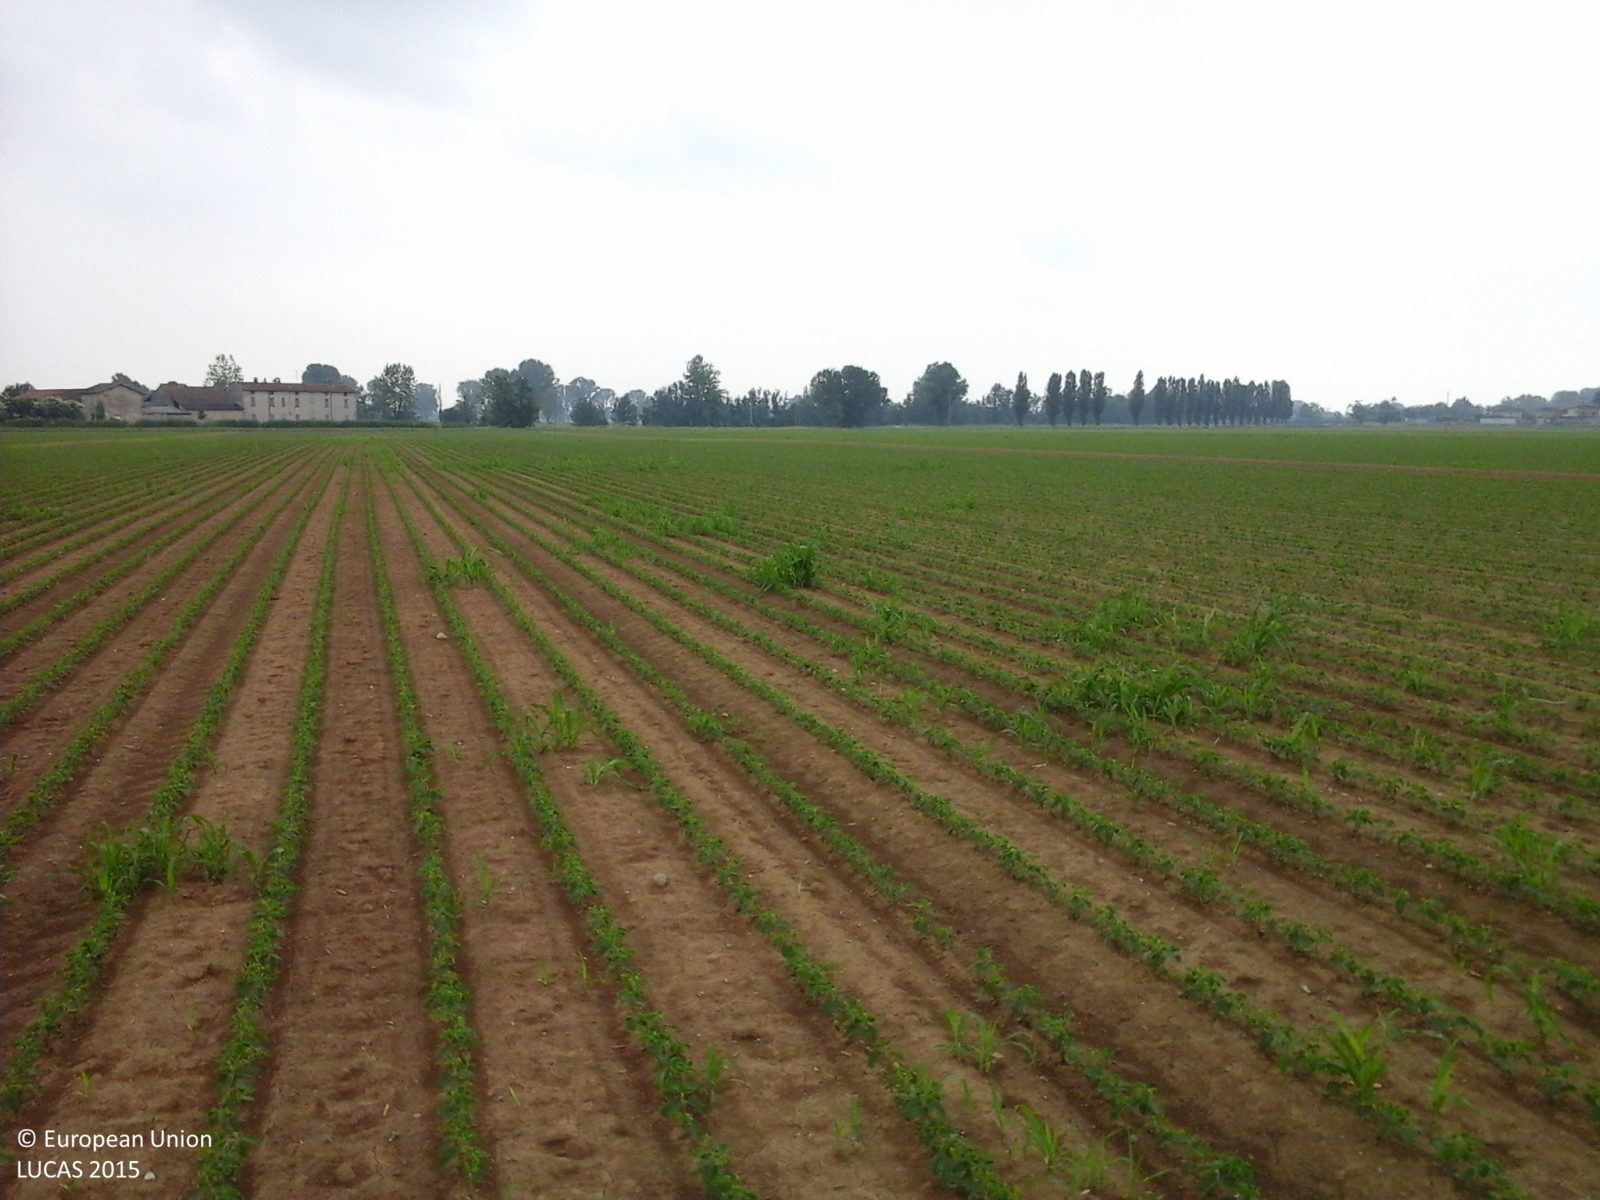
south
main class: Cropland
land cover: Soya
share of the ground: < 10 %
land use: Agriculture (excluding fallow land and kitchen gardens)
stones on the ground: < 10 %
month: May
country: IT
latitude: 45.4669
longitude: 9.4510
